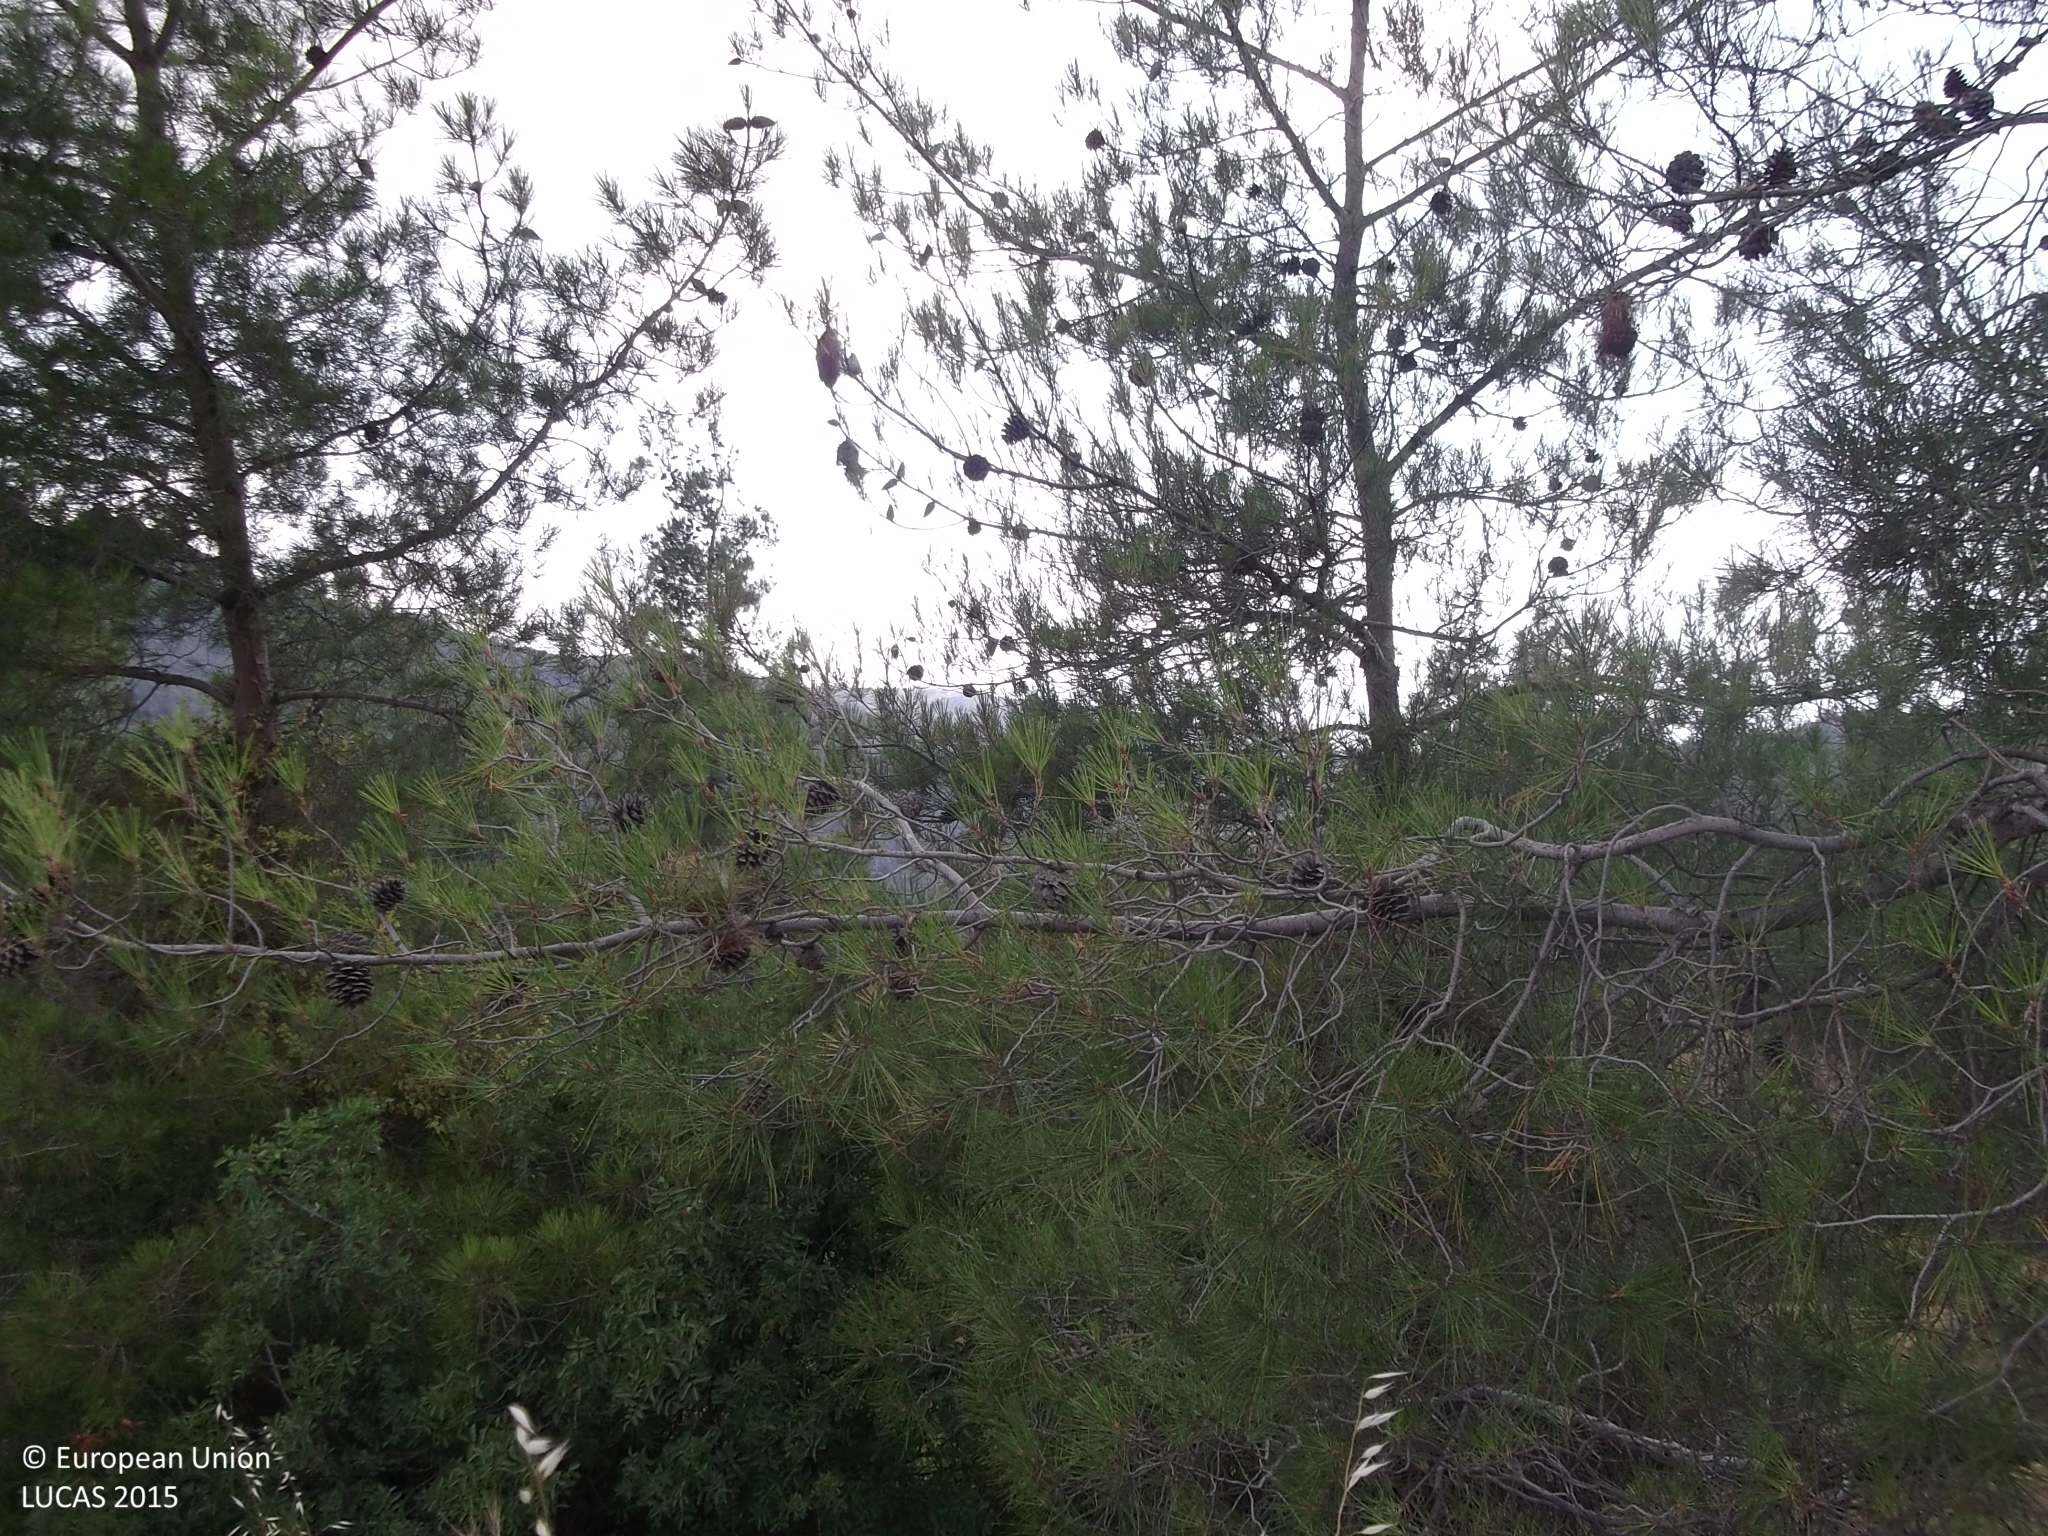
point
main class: Woodland
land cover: Pine dominated coniferous woodland
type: coniferous forest of the mediterranean region
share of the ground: 50 - 75 %
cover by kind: coniferous forest trees 60 %, shrubs 20 %, herbaceous plants 20 %
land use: Forestry
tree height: > 5 m
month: June
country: CY
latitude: 35.0487
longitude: 32.5110
